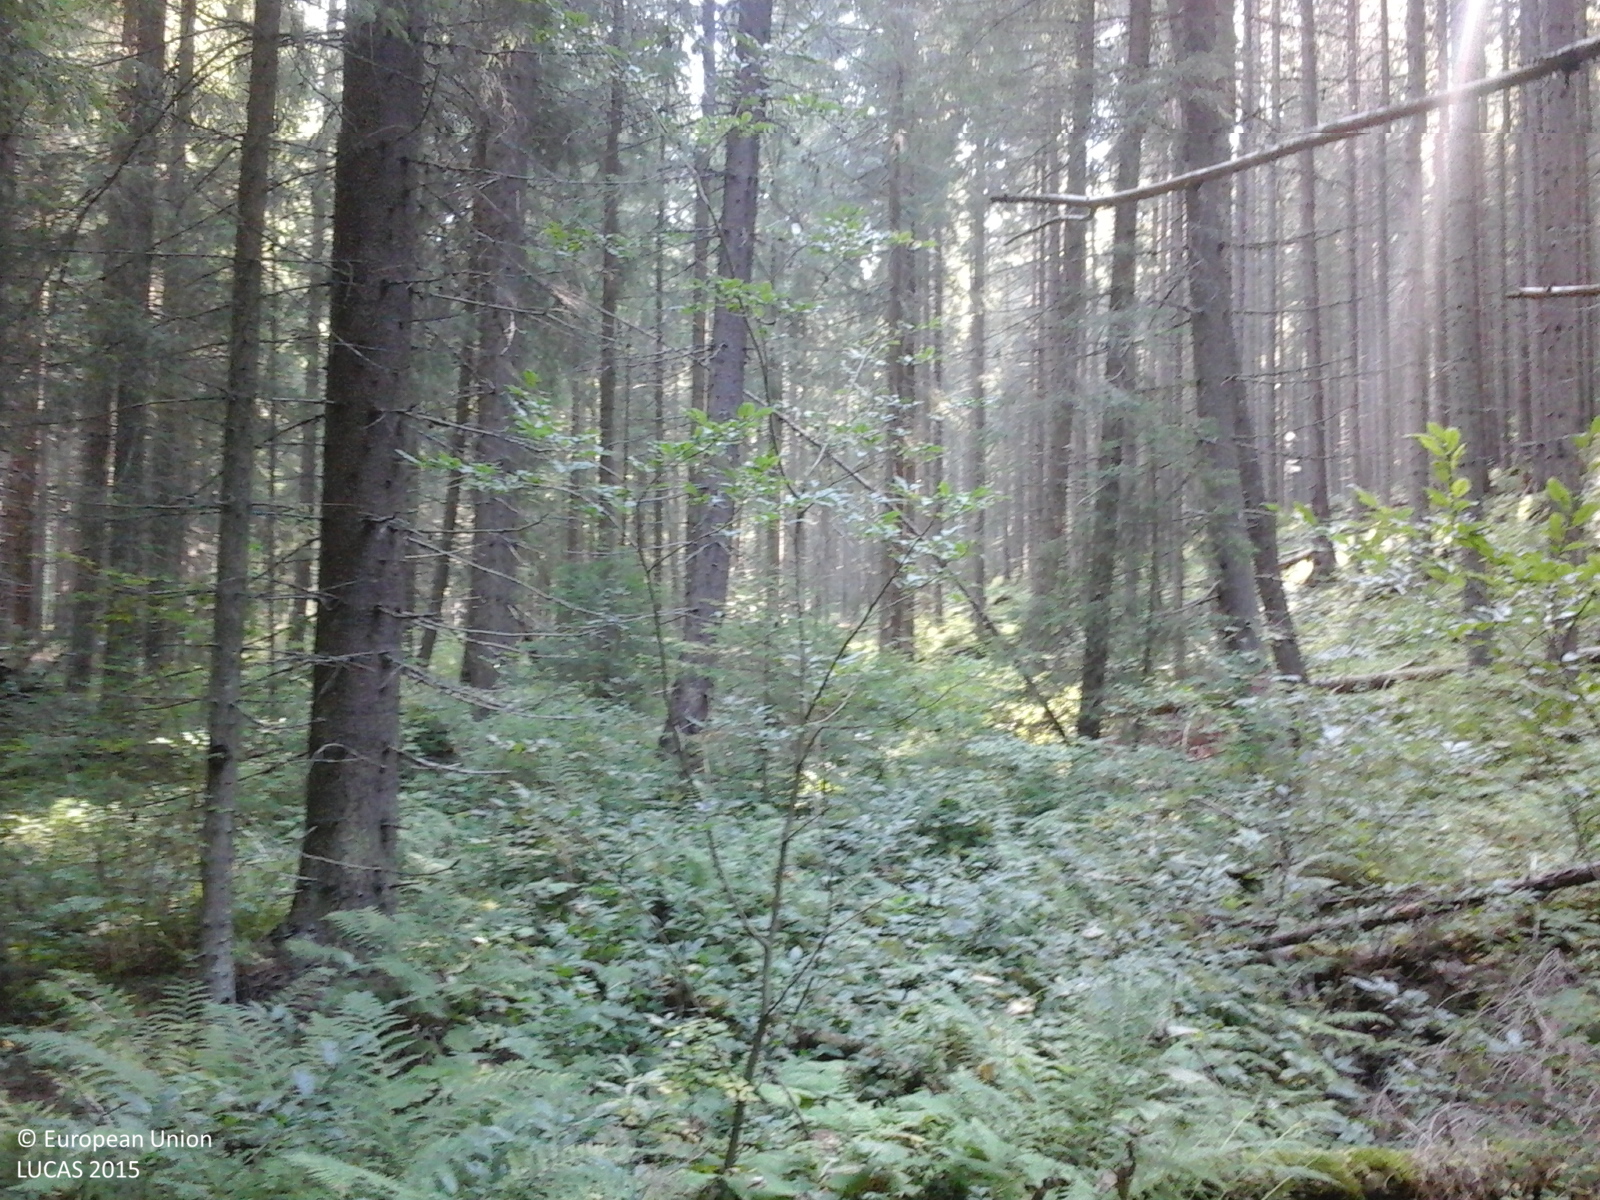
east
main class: Woodland
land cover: Spruce dominated coniferous woodland
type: alpine coniferous forest
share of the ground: > 75 %
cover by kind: coniferous forest trees 100 %
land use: Forestry
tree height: > 5 m
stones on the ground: < 10 %
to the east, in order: Spruce dominated coniferous woodland; Rivers and streams; Spruce dominated coniferous woodland
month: September
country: RO
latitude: 47.2487
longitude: 25.1011
